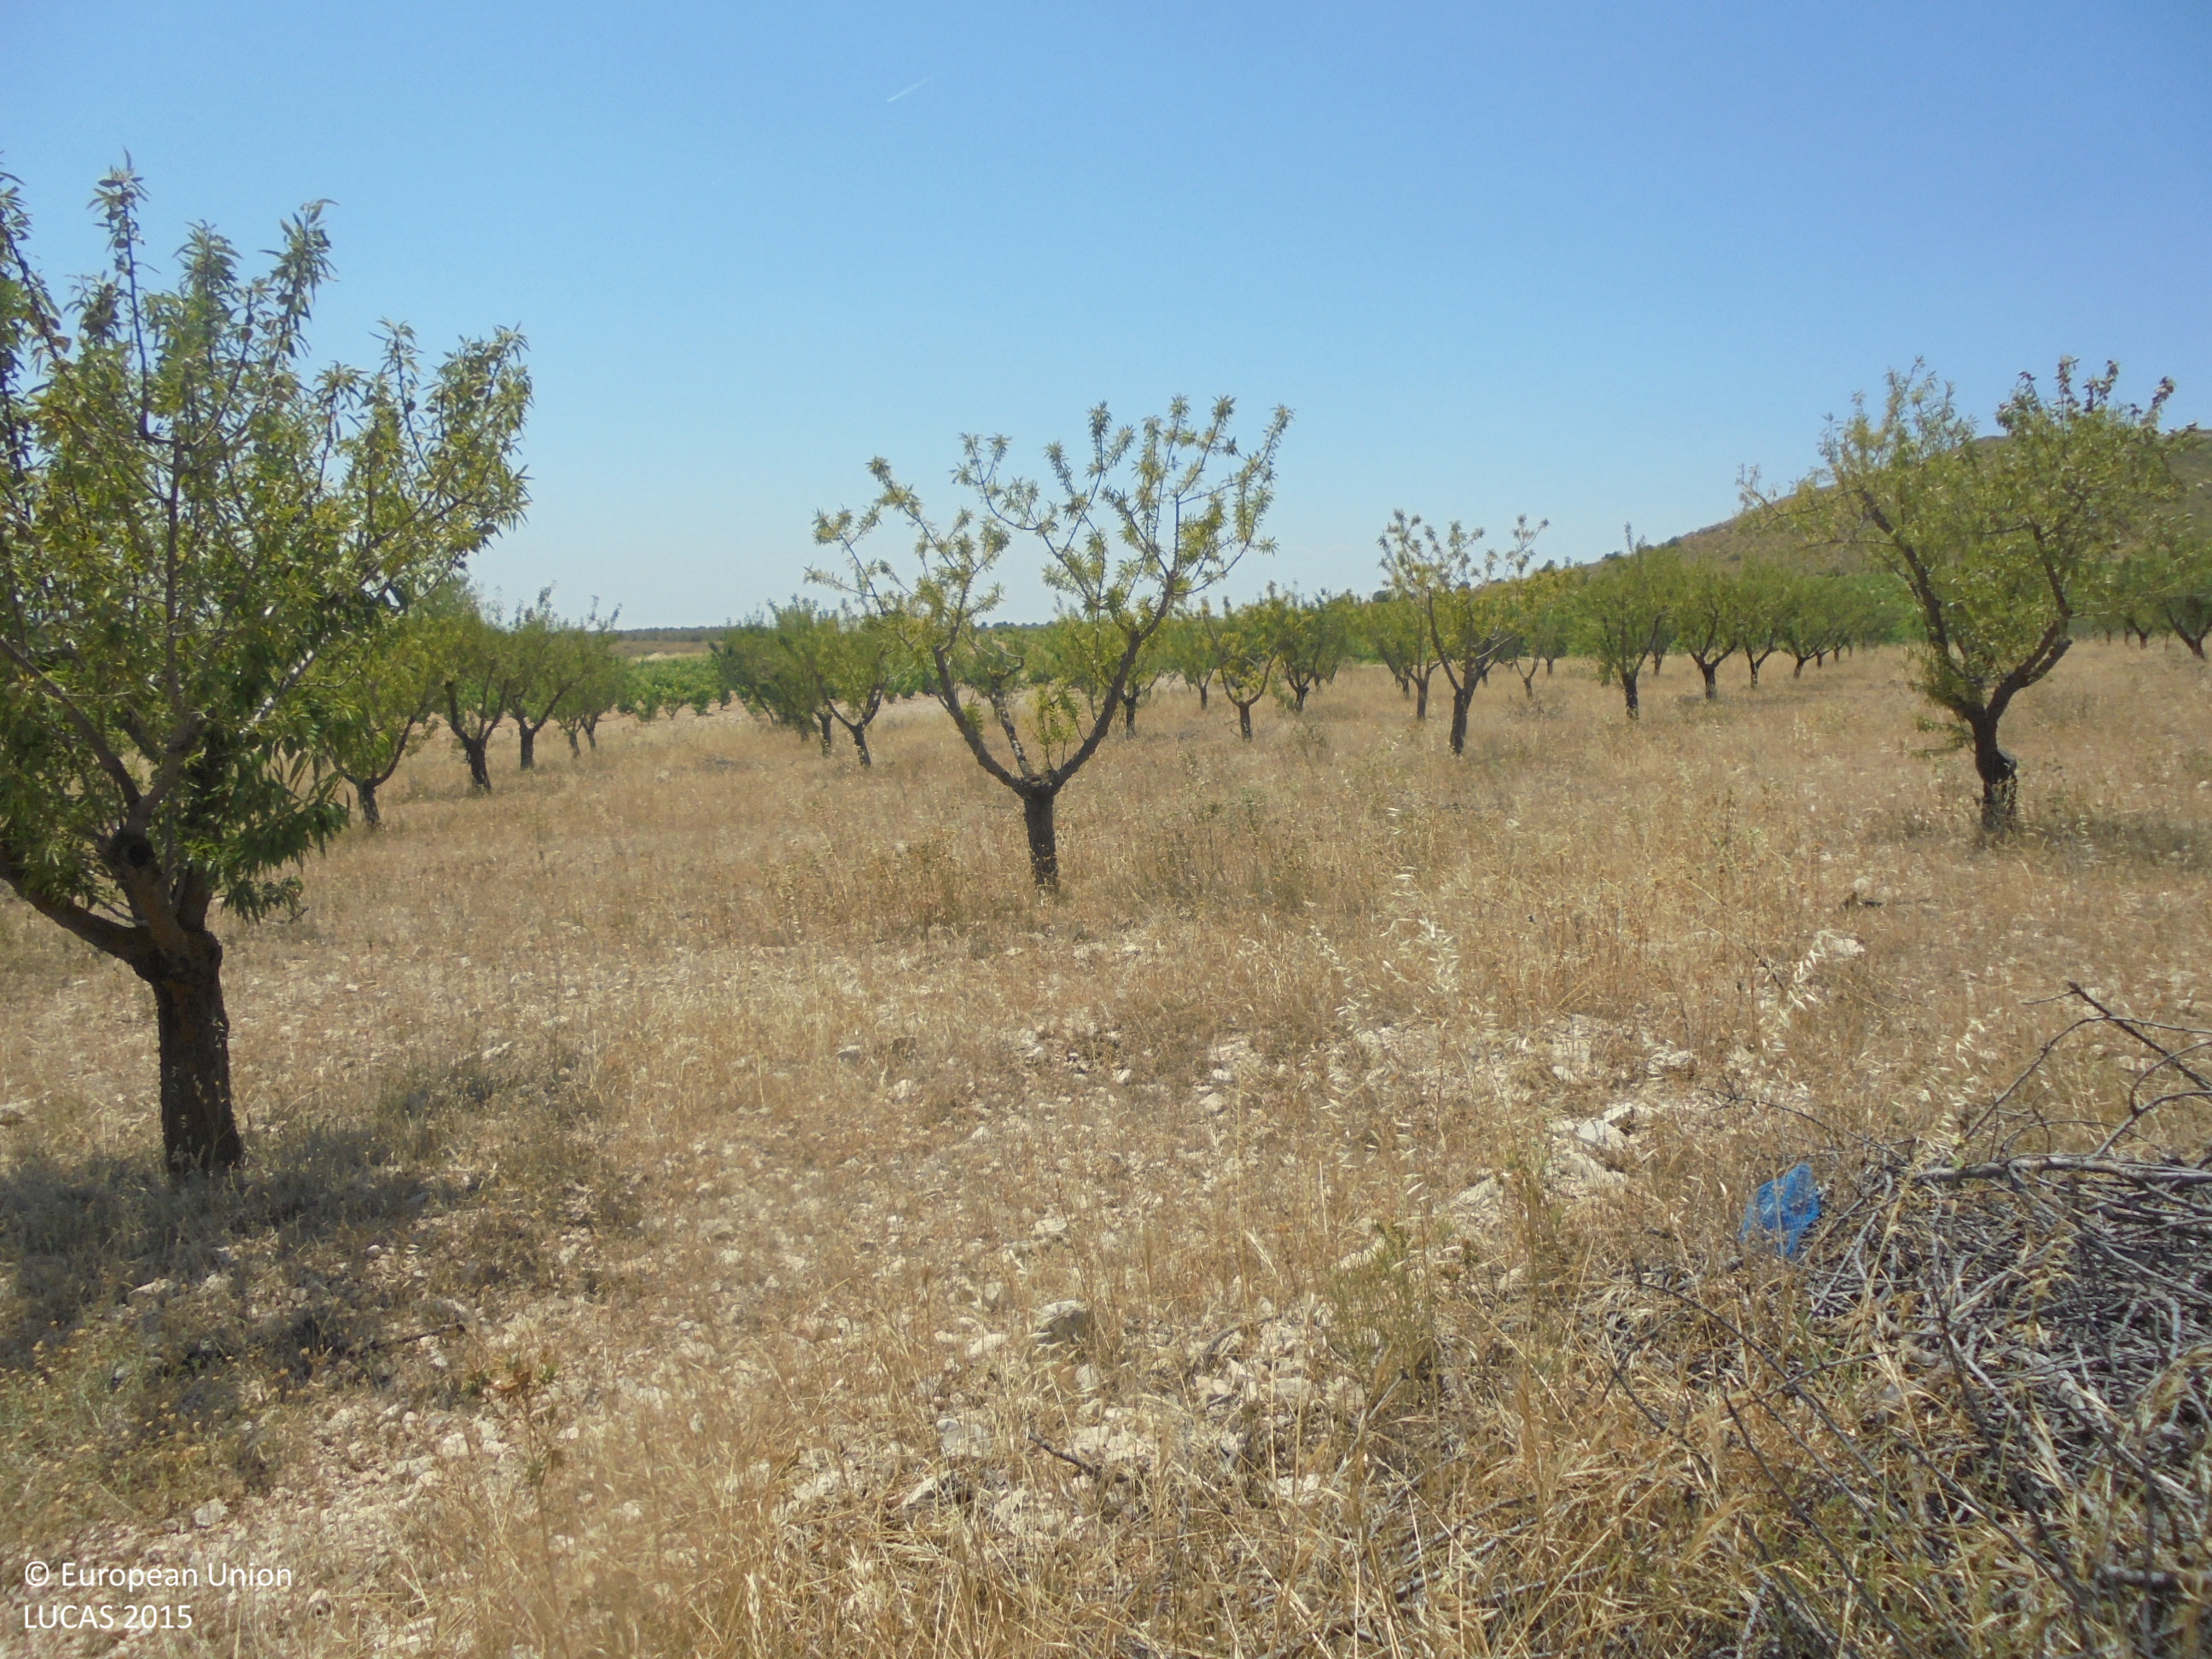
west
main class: Shrubland
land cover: Shrubland without tree cover
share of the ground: > 75 %
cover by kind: shrubs 90 %, unconsolidated bare surface 10 %
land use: Abandoned areas
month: July
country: ES
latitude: 38.7345
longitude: -1.4639
